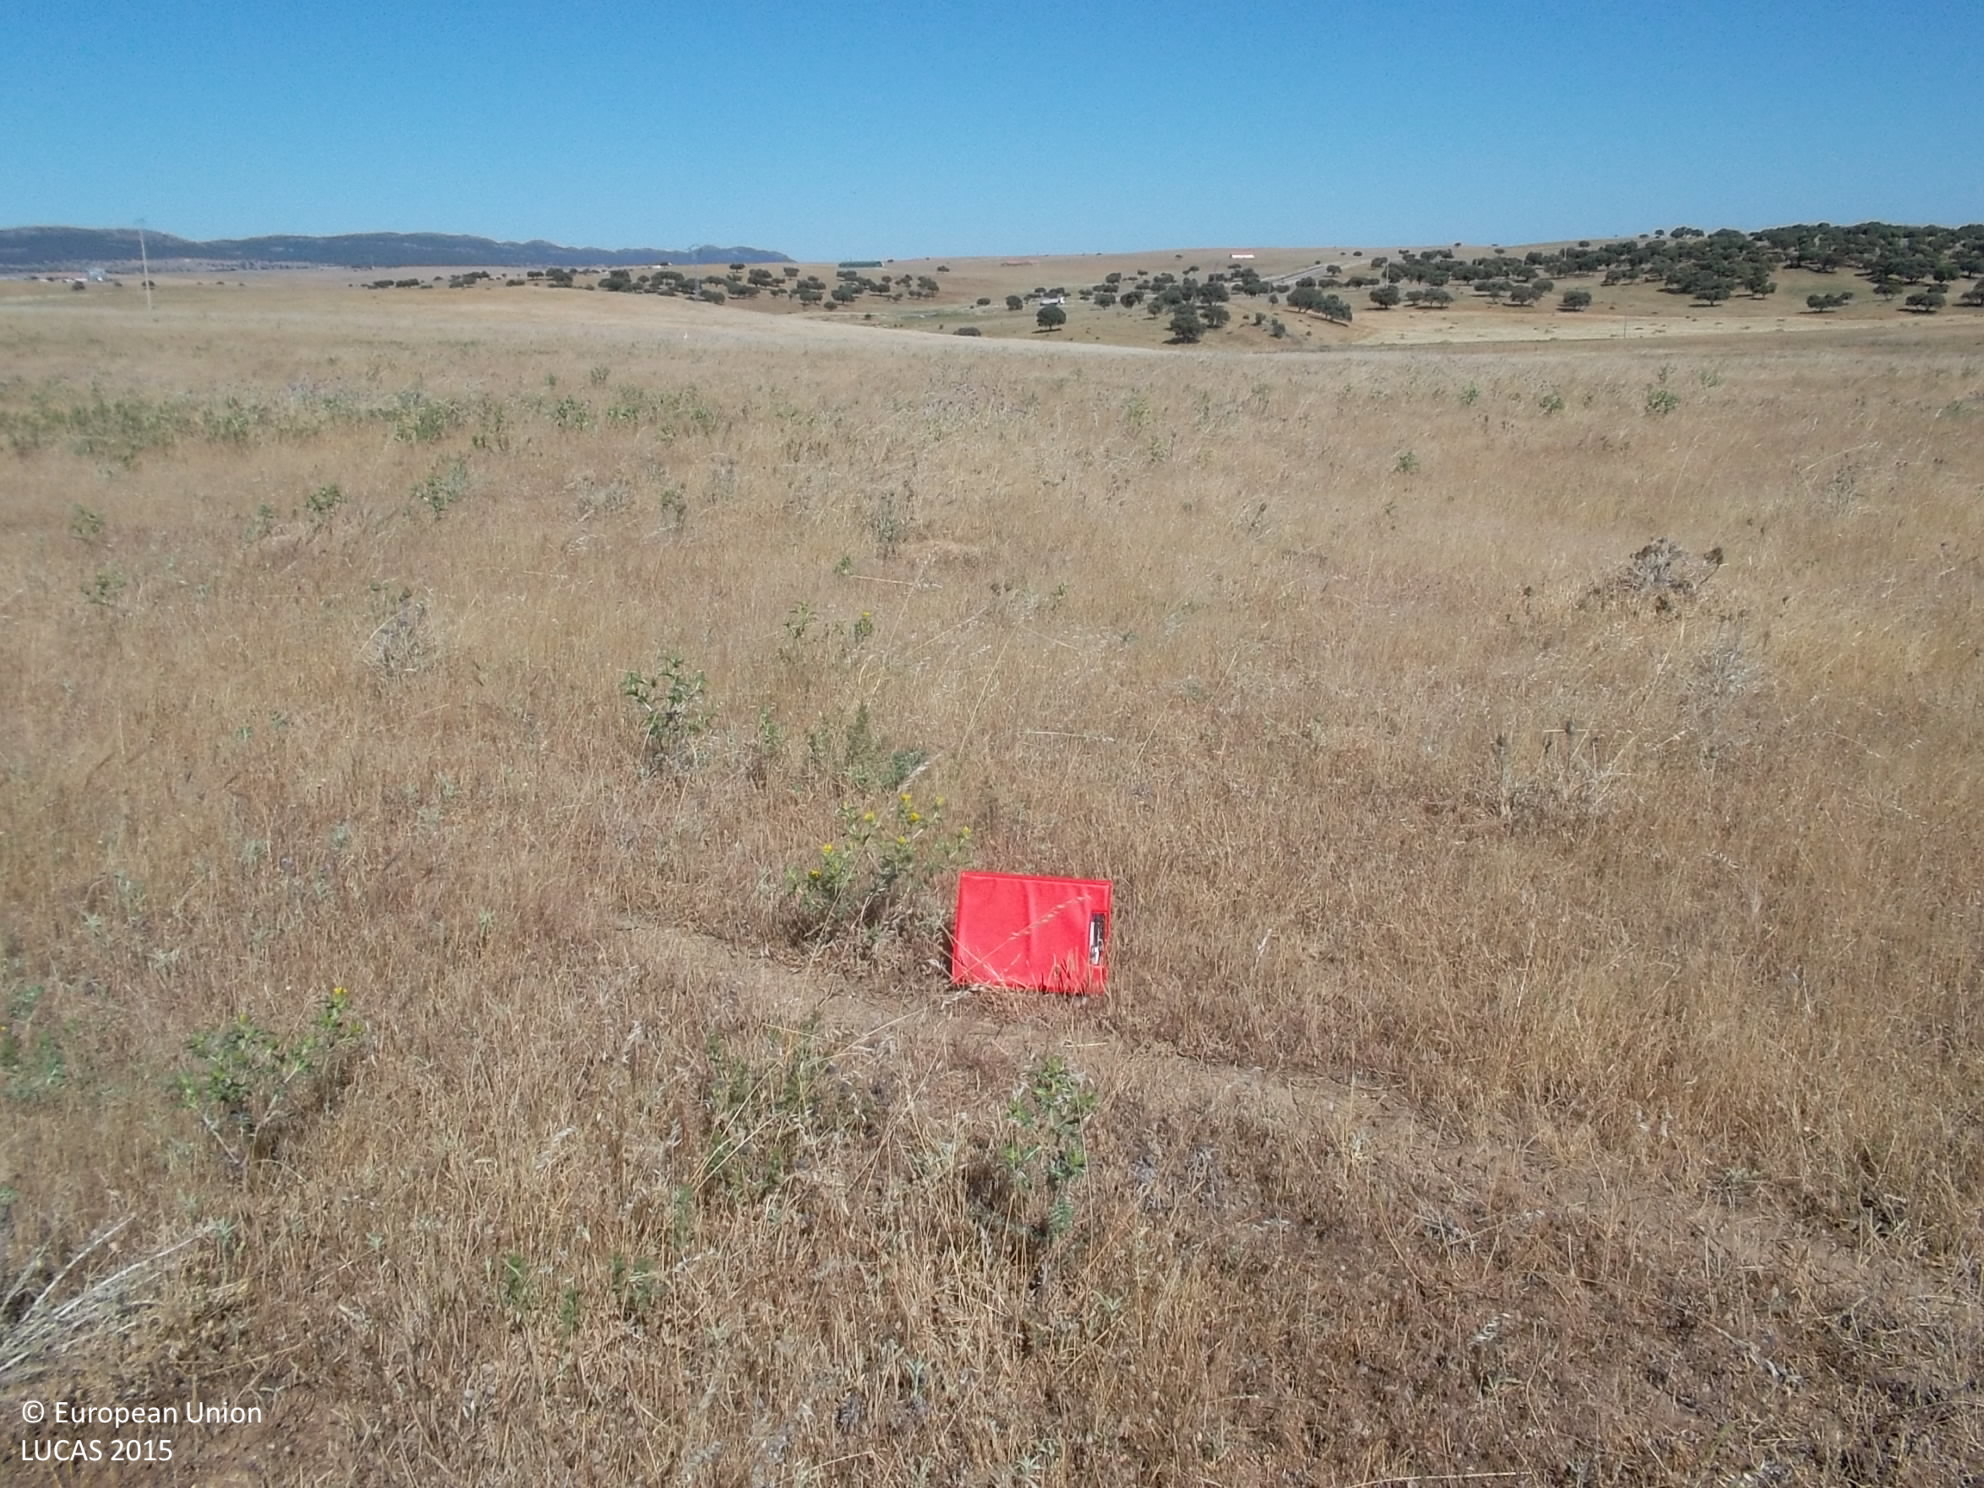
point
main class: Grassland
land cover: Grassland without tree/shrub cover
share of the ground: > 75 %
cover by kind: herbaceous plants 100 %
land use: Agriculture (excluding fallow land and kitchen gardens)
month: May
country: ES
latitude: 38.6243
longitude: -4.4368
